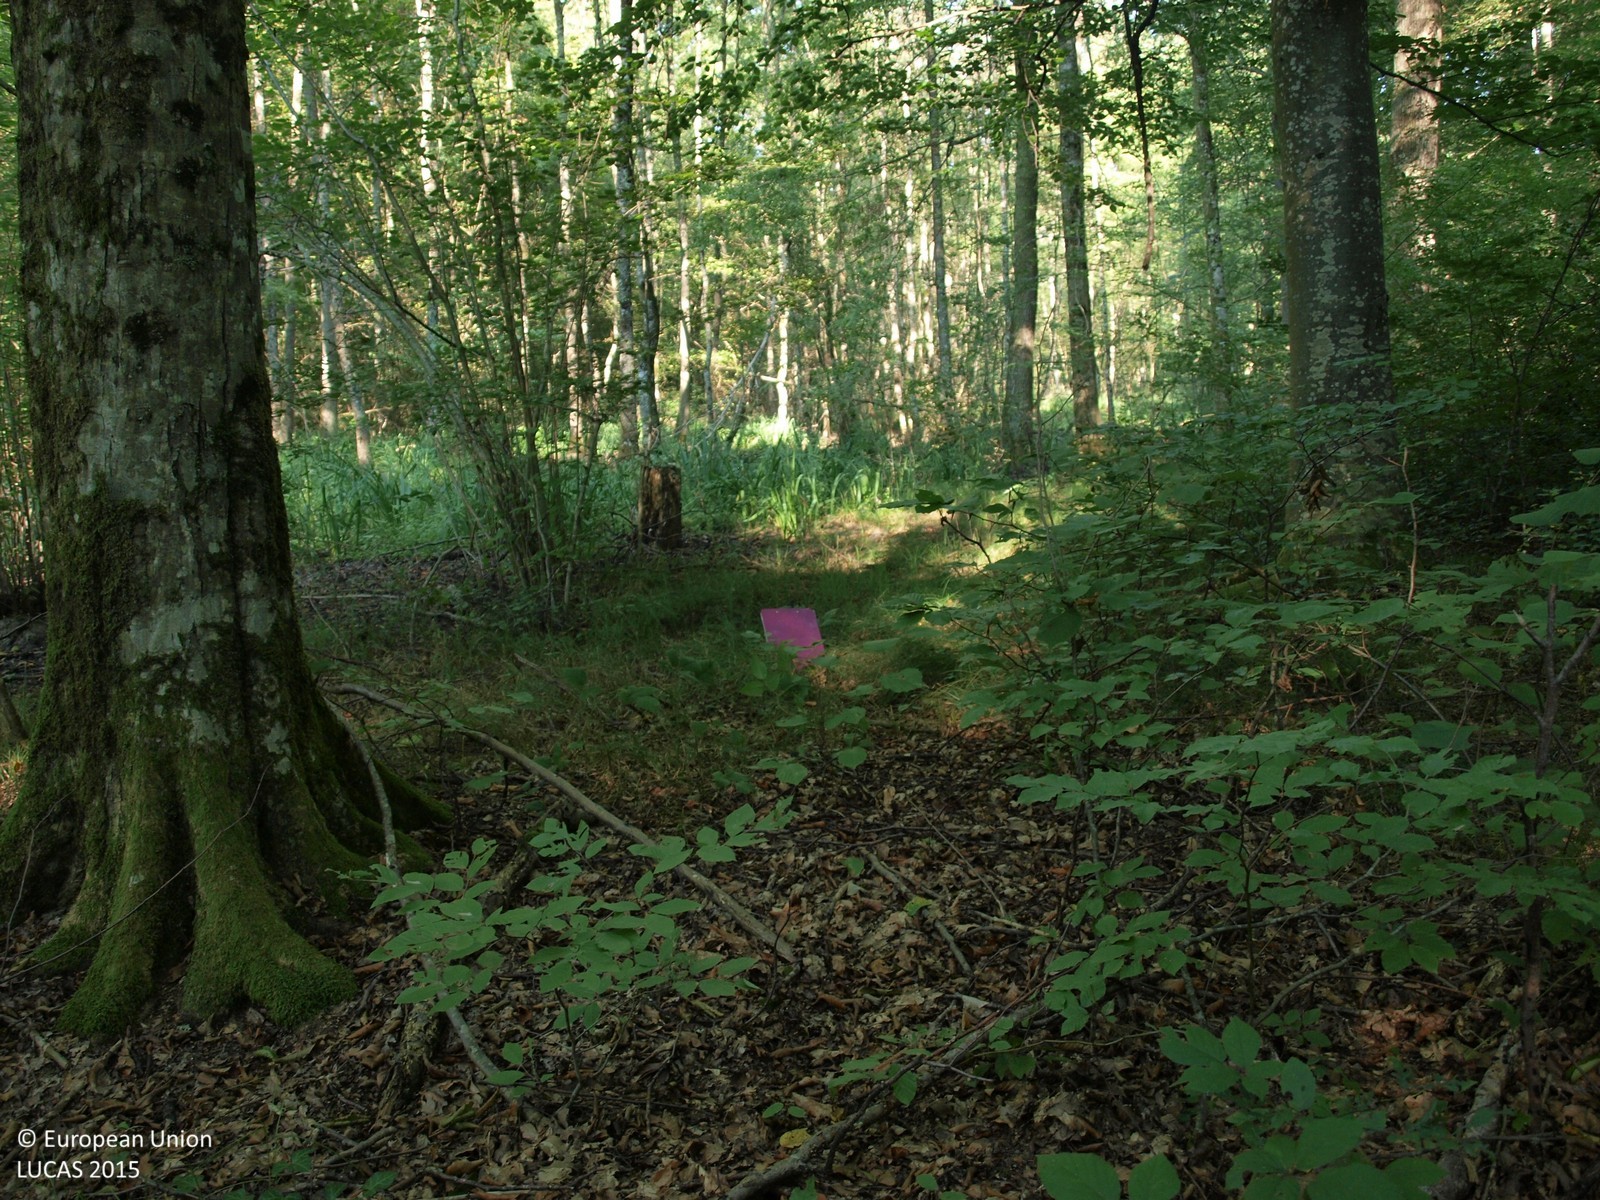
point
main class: Woodland
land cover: Broadleaved woodland
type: floodplain forest
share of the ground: > 75 %
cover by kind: broadleaved forest trees 100 %
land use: Forestry
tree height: > 5 m
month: August
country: HR
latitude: 45.6324
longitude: 16.4508
